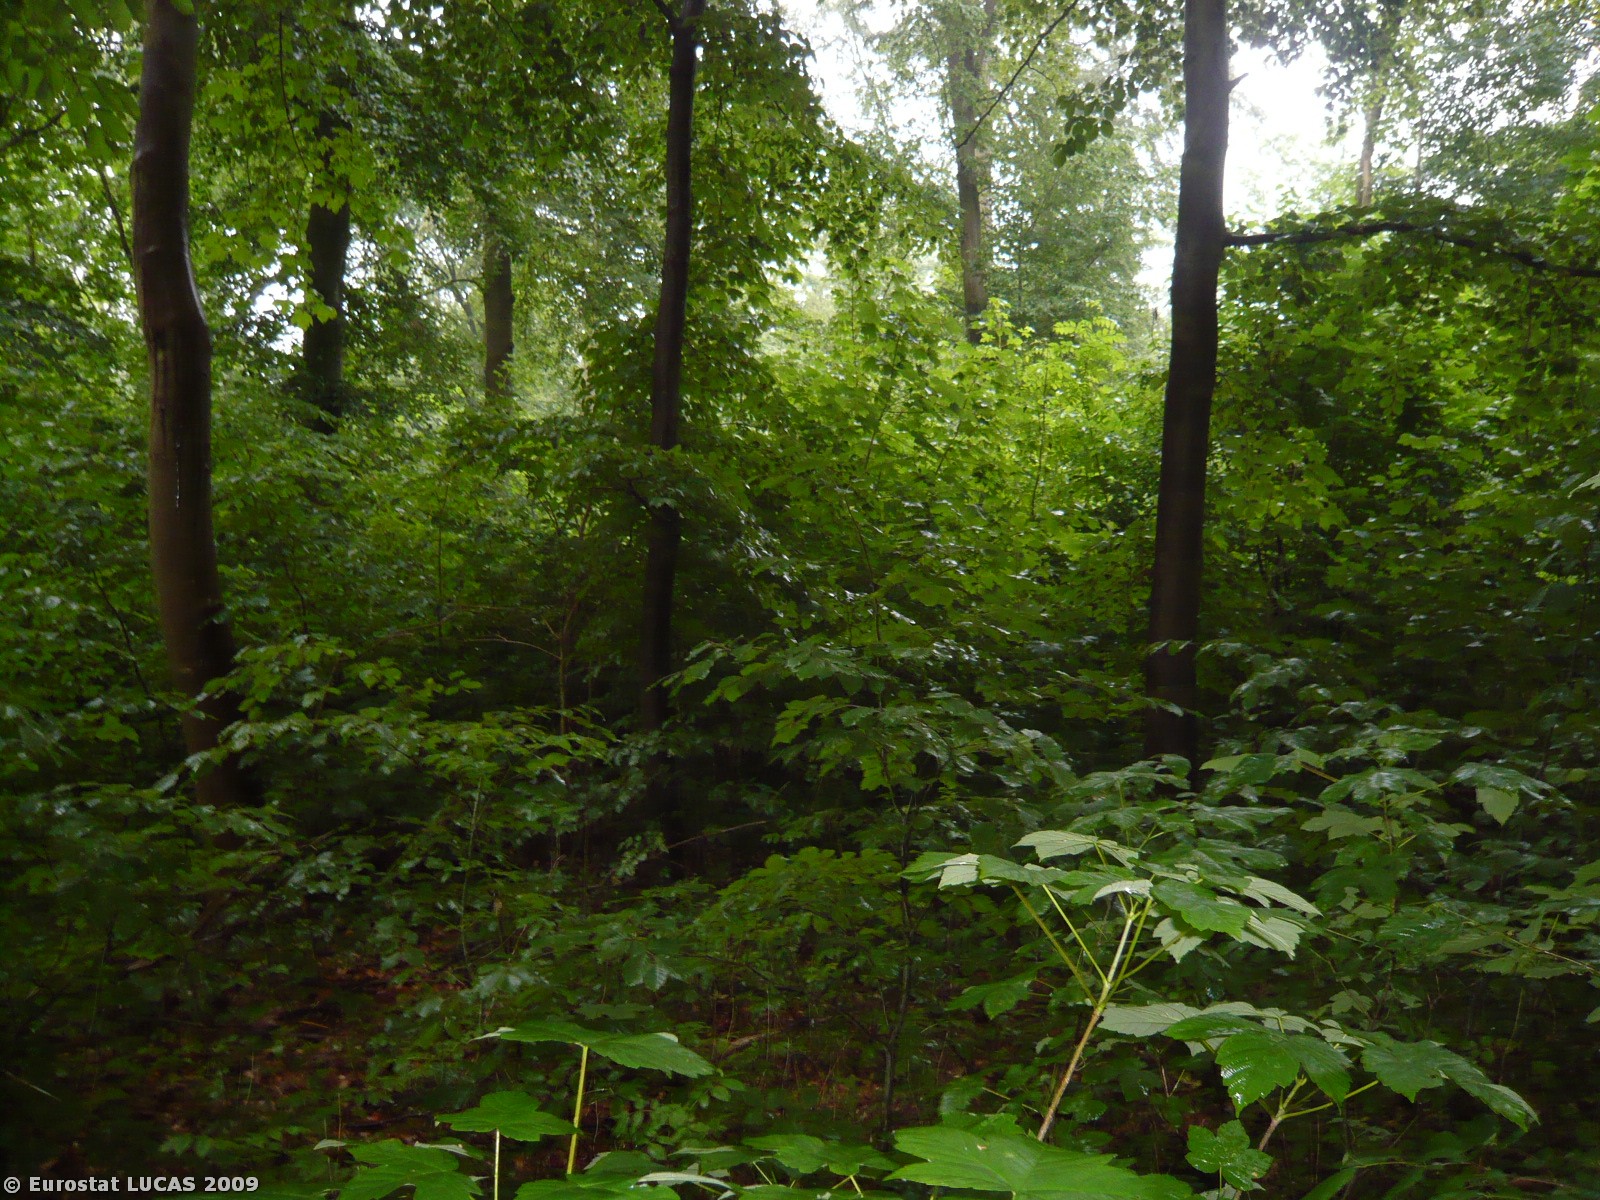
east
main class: Woodland
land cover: Broadleaved woodland
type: mesophytic deciduous forest
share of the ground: > 75 %
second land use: Amenities, museums, leisure
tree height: > 5 m
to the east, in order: Broadleaved woodland
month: June
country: DK
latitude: 54.7914
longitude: 11.7563
